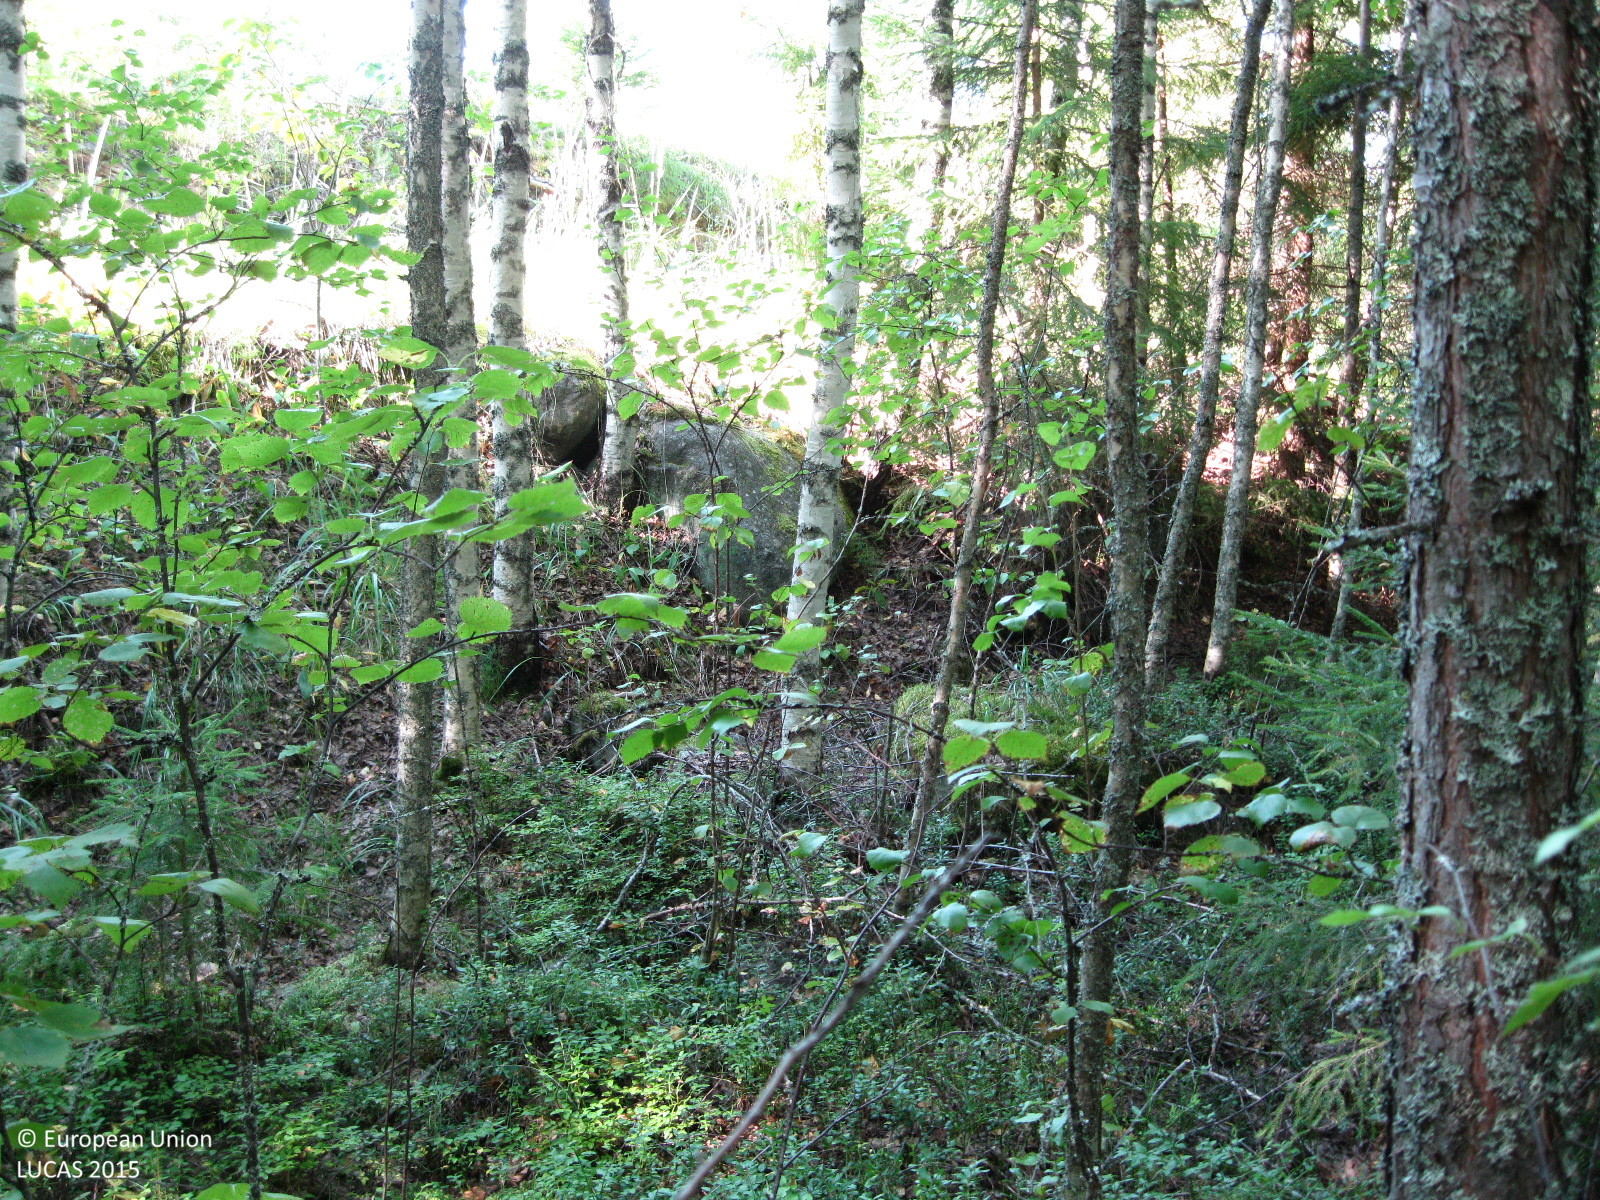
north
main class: Woodland
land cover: Pine dominated mixed woodland
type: boreal forest
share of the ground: > 75 %
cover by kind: broadleaved forest trees 55 %, coniferous forest trees 45 %
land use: Forestry
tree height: > 5 m
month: August
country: FI
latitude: 61.2432
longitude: 25.0378
